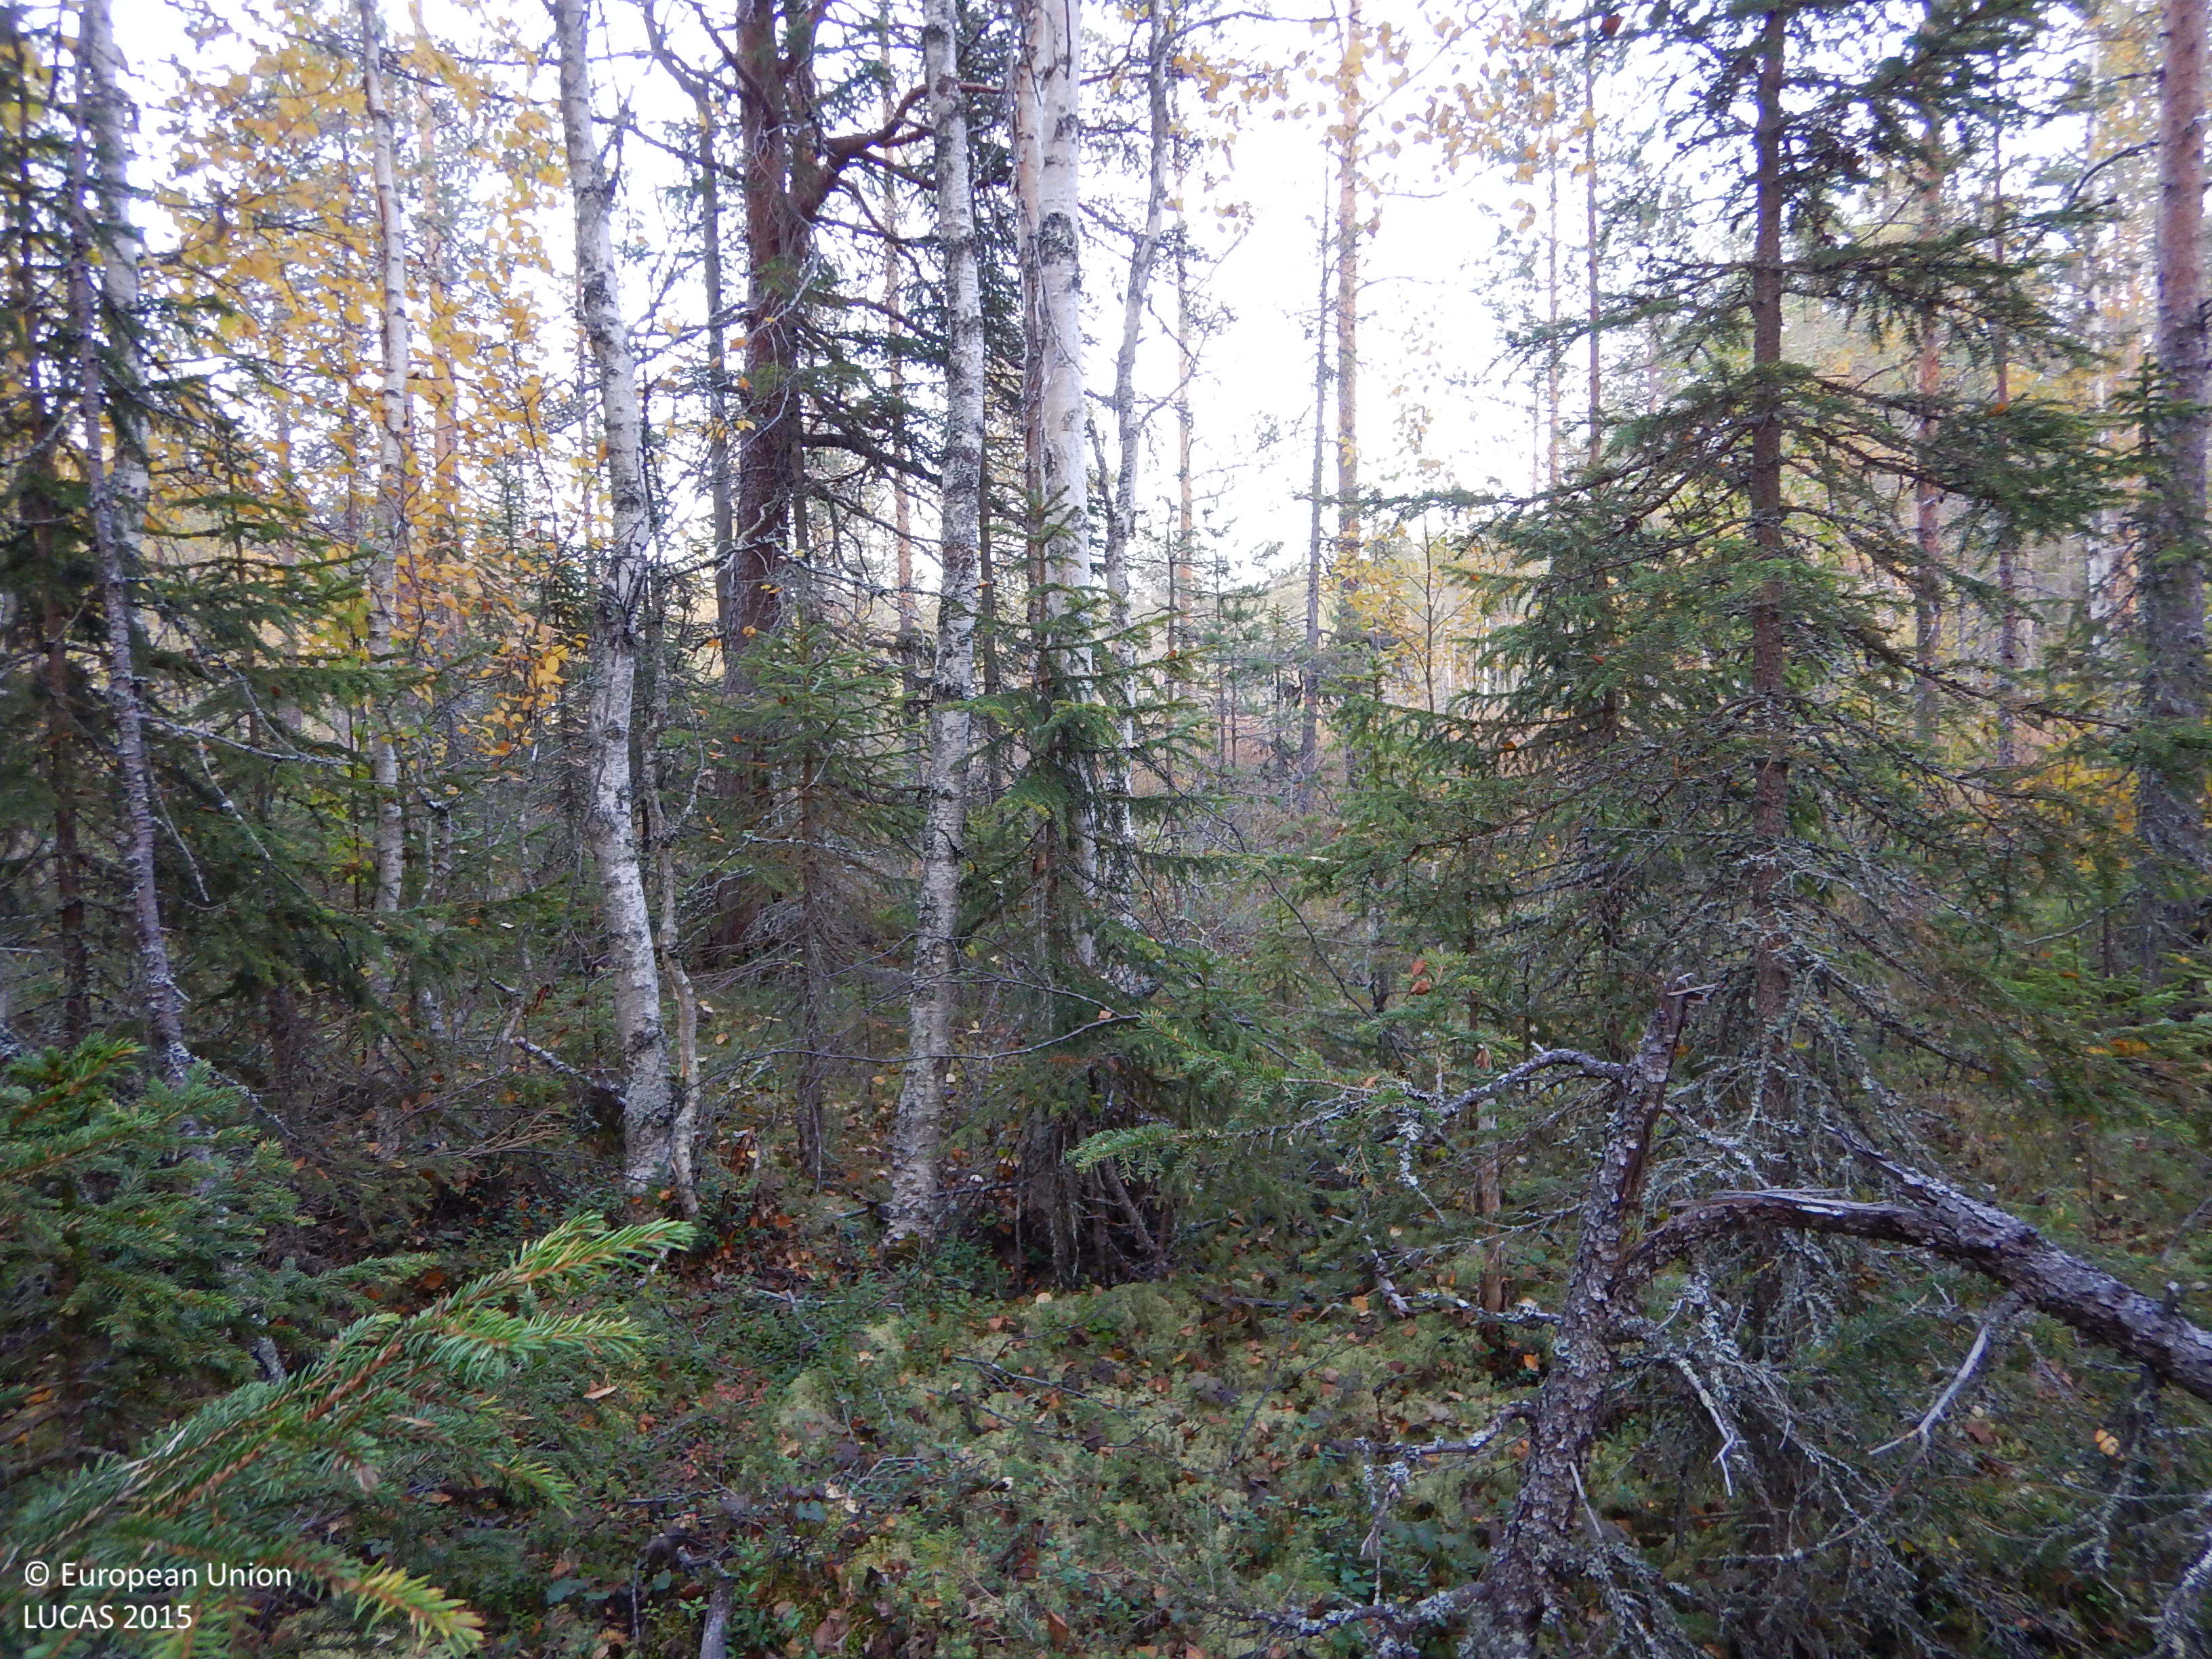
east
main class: Woodland
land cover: Other mixed woodland
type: mire and swamp forests
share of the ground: 50 - 75 %
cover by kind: coniferous forest trees 35 %, broadleaved forest trees 20 %, herbaceous plants 20 %, lichens and mosses 20 %, shrubs 5 %
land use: Forestry
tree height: > 5 m
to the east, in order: Other mixed woodland; Peatbogs; Pine dominated mixed woodland; Ditches and canals; Broadleaved woodland; Paved roads, cycling and walking lanes; Broadleaved woodland; Ditches and canals; Other mixed woodland; Ditches and canals; Spruce dominated mixed woodland
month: September
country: SE
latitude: 64.7107
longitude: 20.1483
